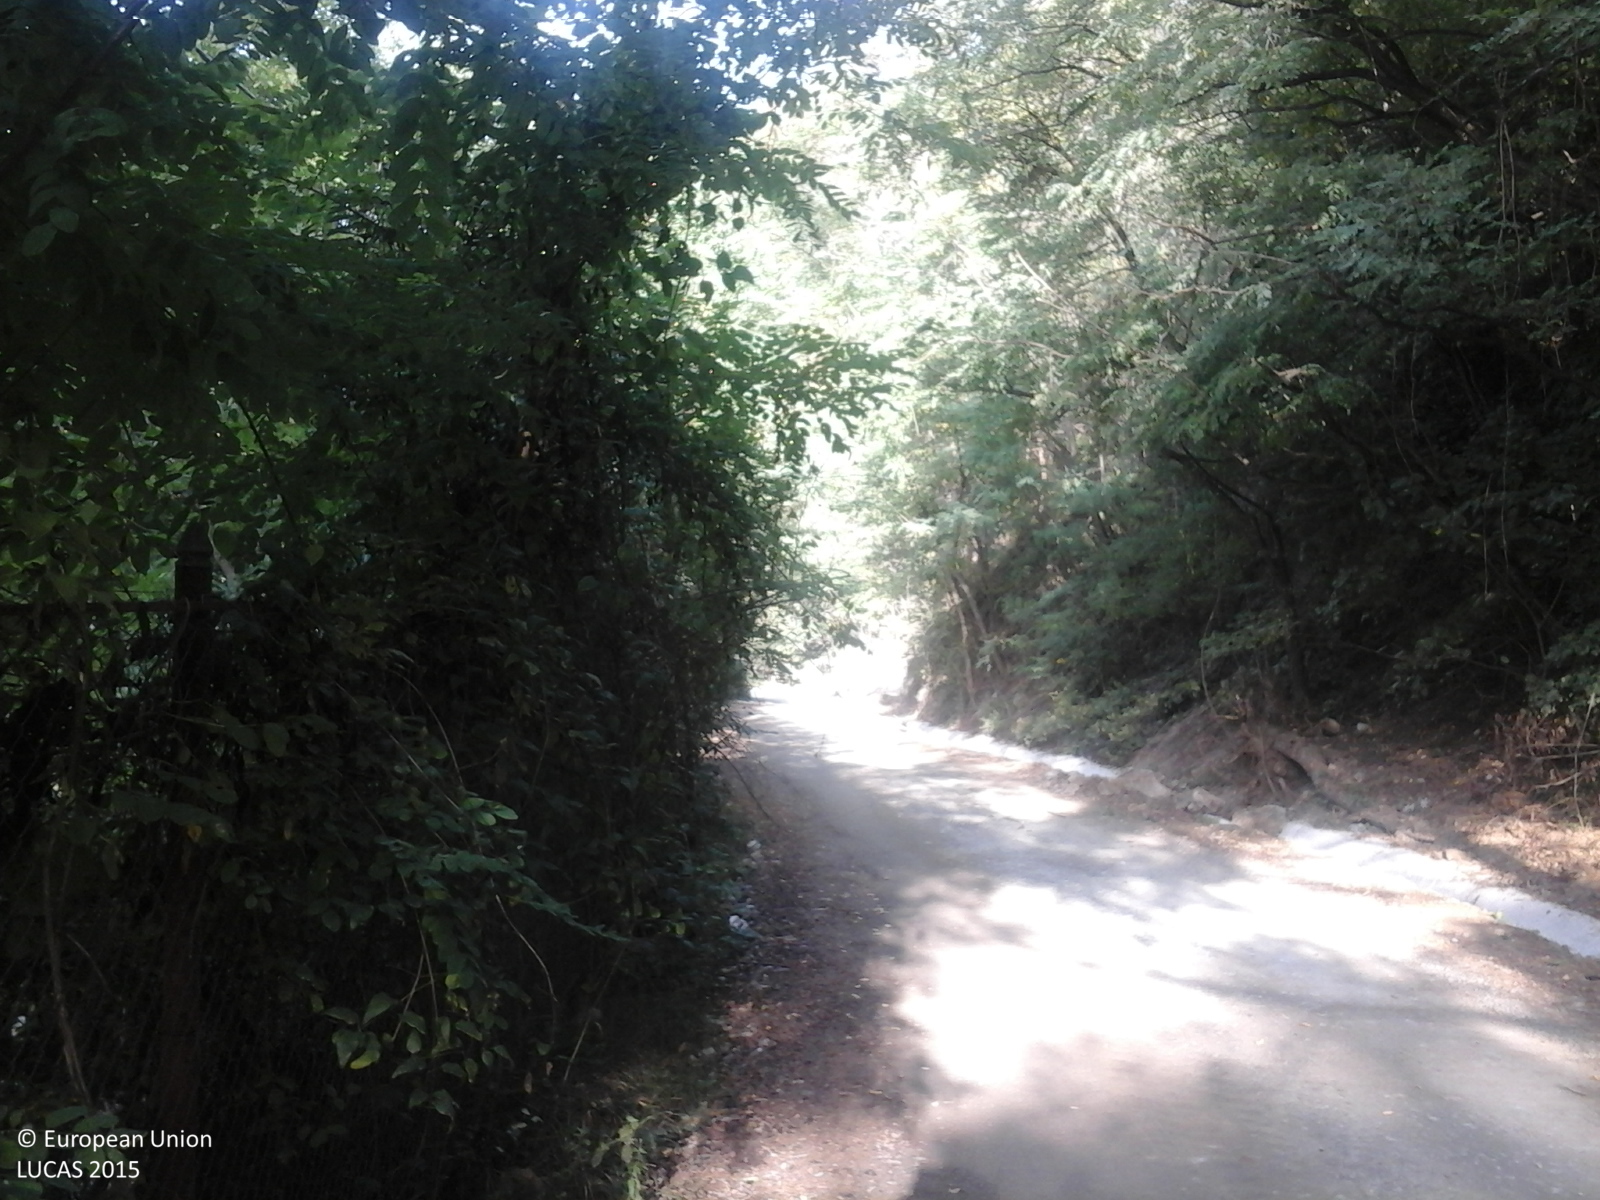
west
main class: Woodland
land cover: Broadleaved woodland
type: beech forest
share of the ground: > 75 %
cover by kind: broadleaved forest trees 100 %
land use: Forestry
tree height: > 5 m
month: September
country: RO
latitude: 46.7356
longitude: 23.3231
